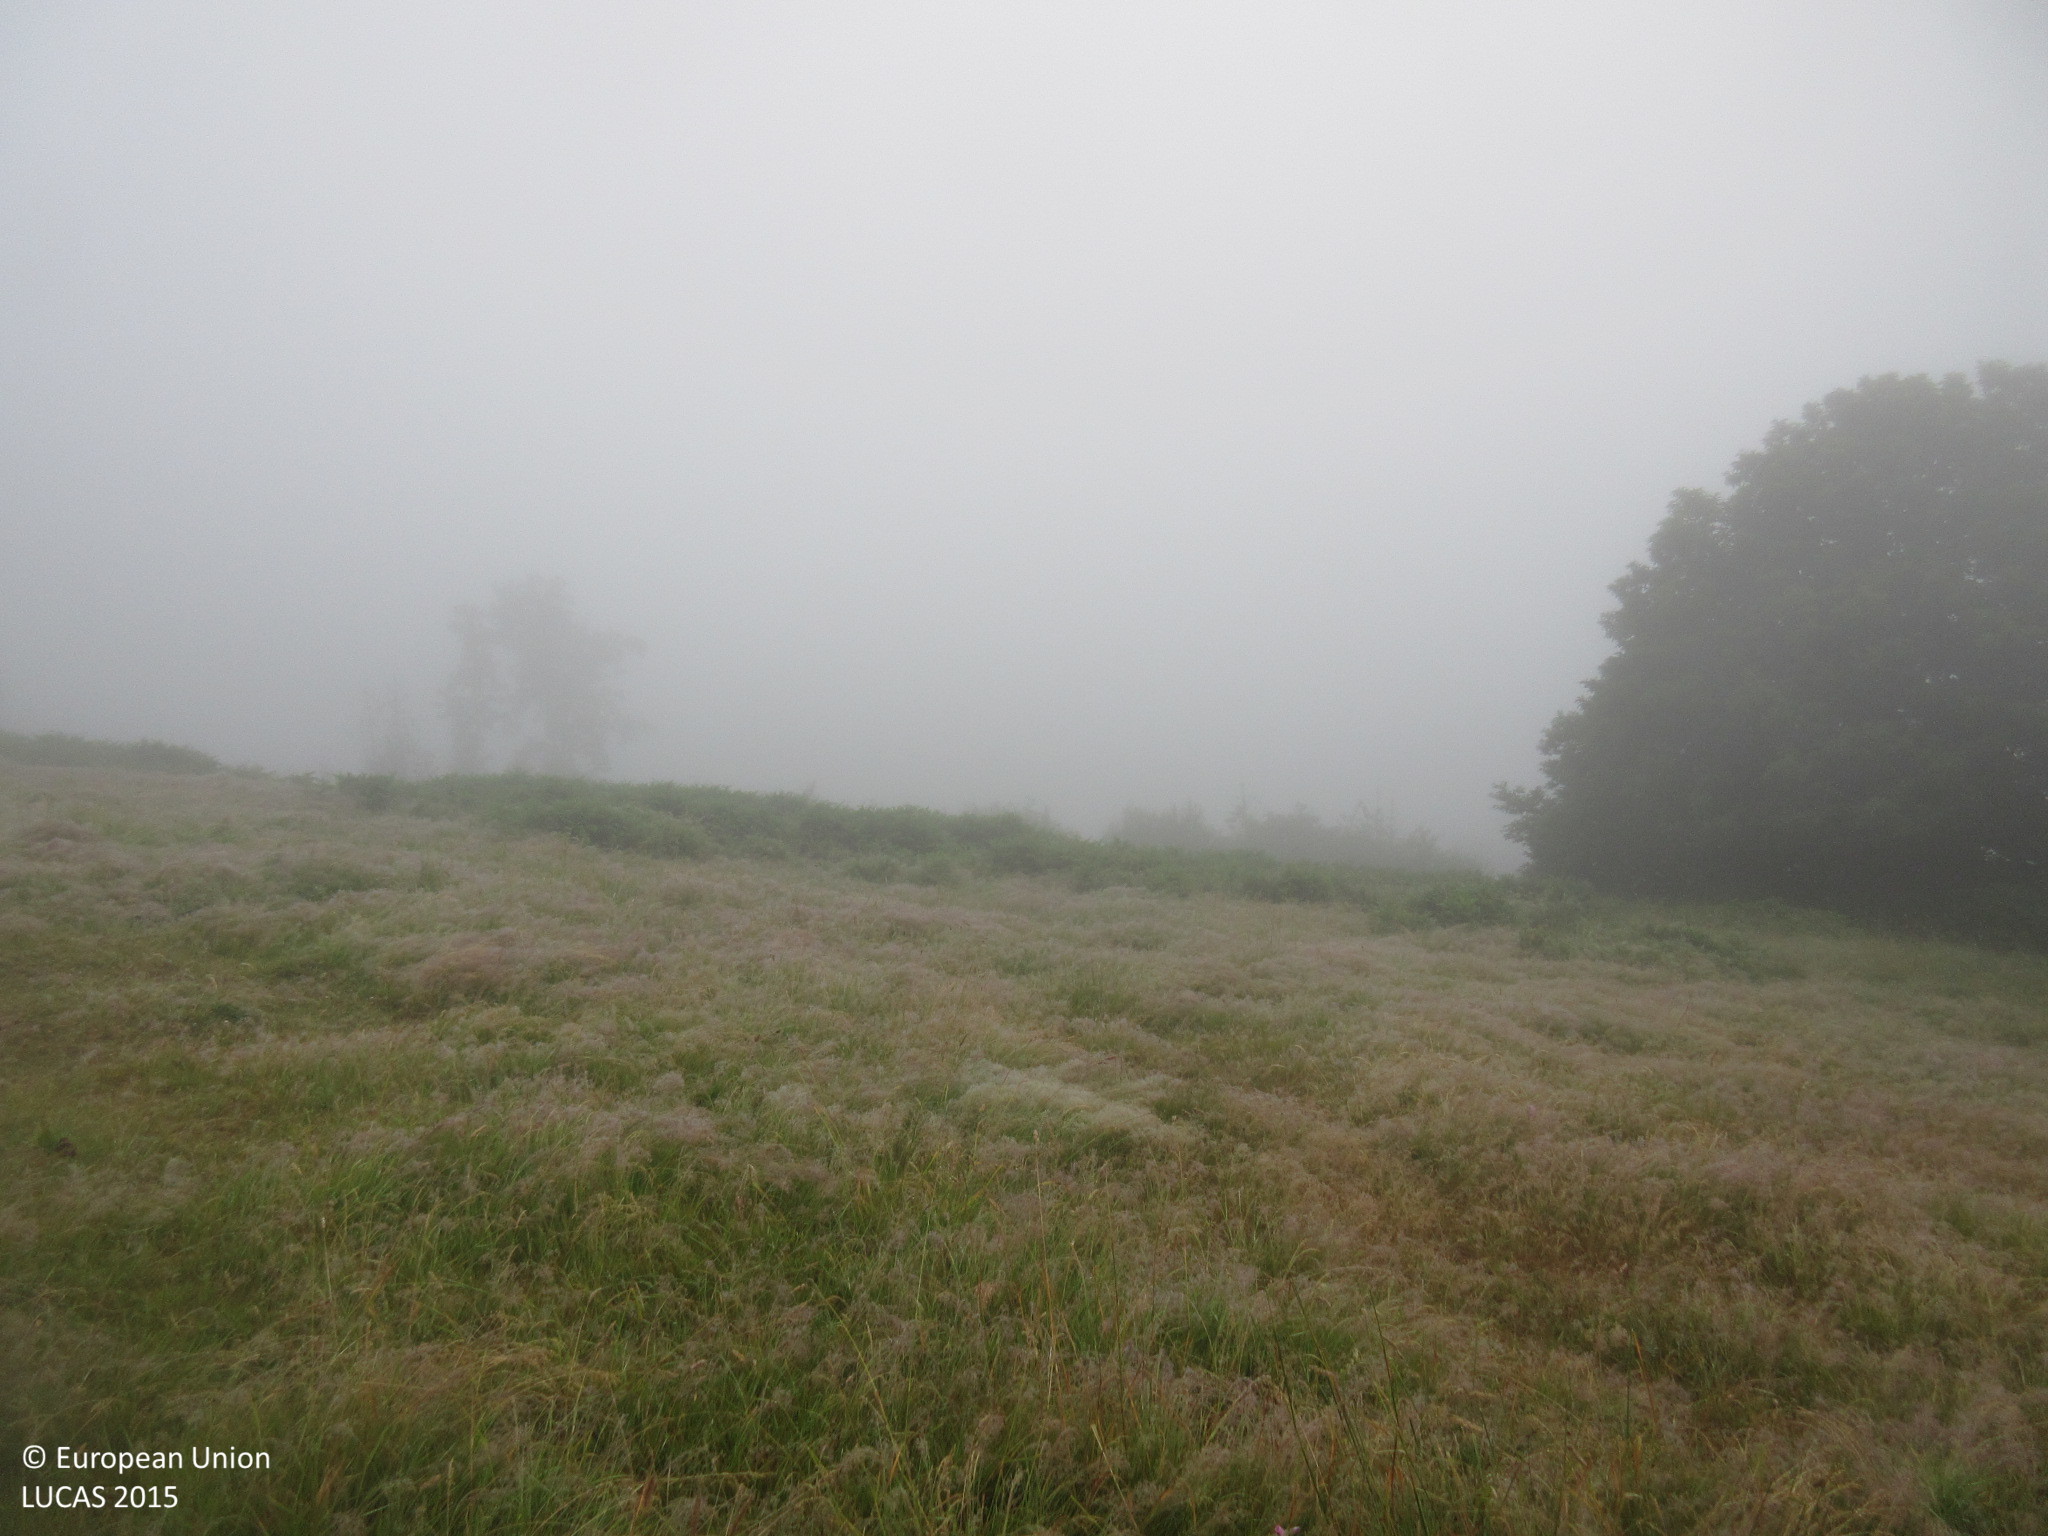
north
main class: Grassland
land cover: Grassland without tree/shrub cover
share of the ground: > 75 %
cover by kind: herbaceous plants 100 %
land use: Agriculture (excluding fallow land and kitchen gardens)
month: June
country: ES
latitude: 43.2399
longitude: -7.0483
